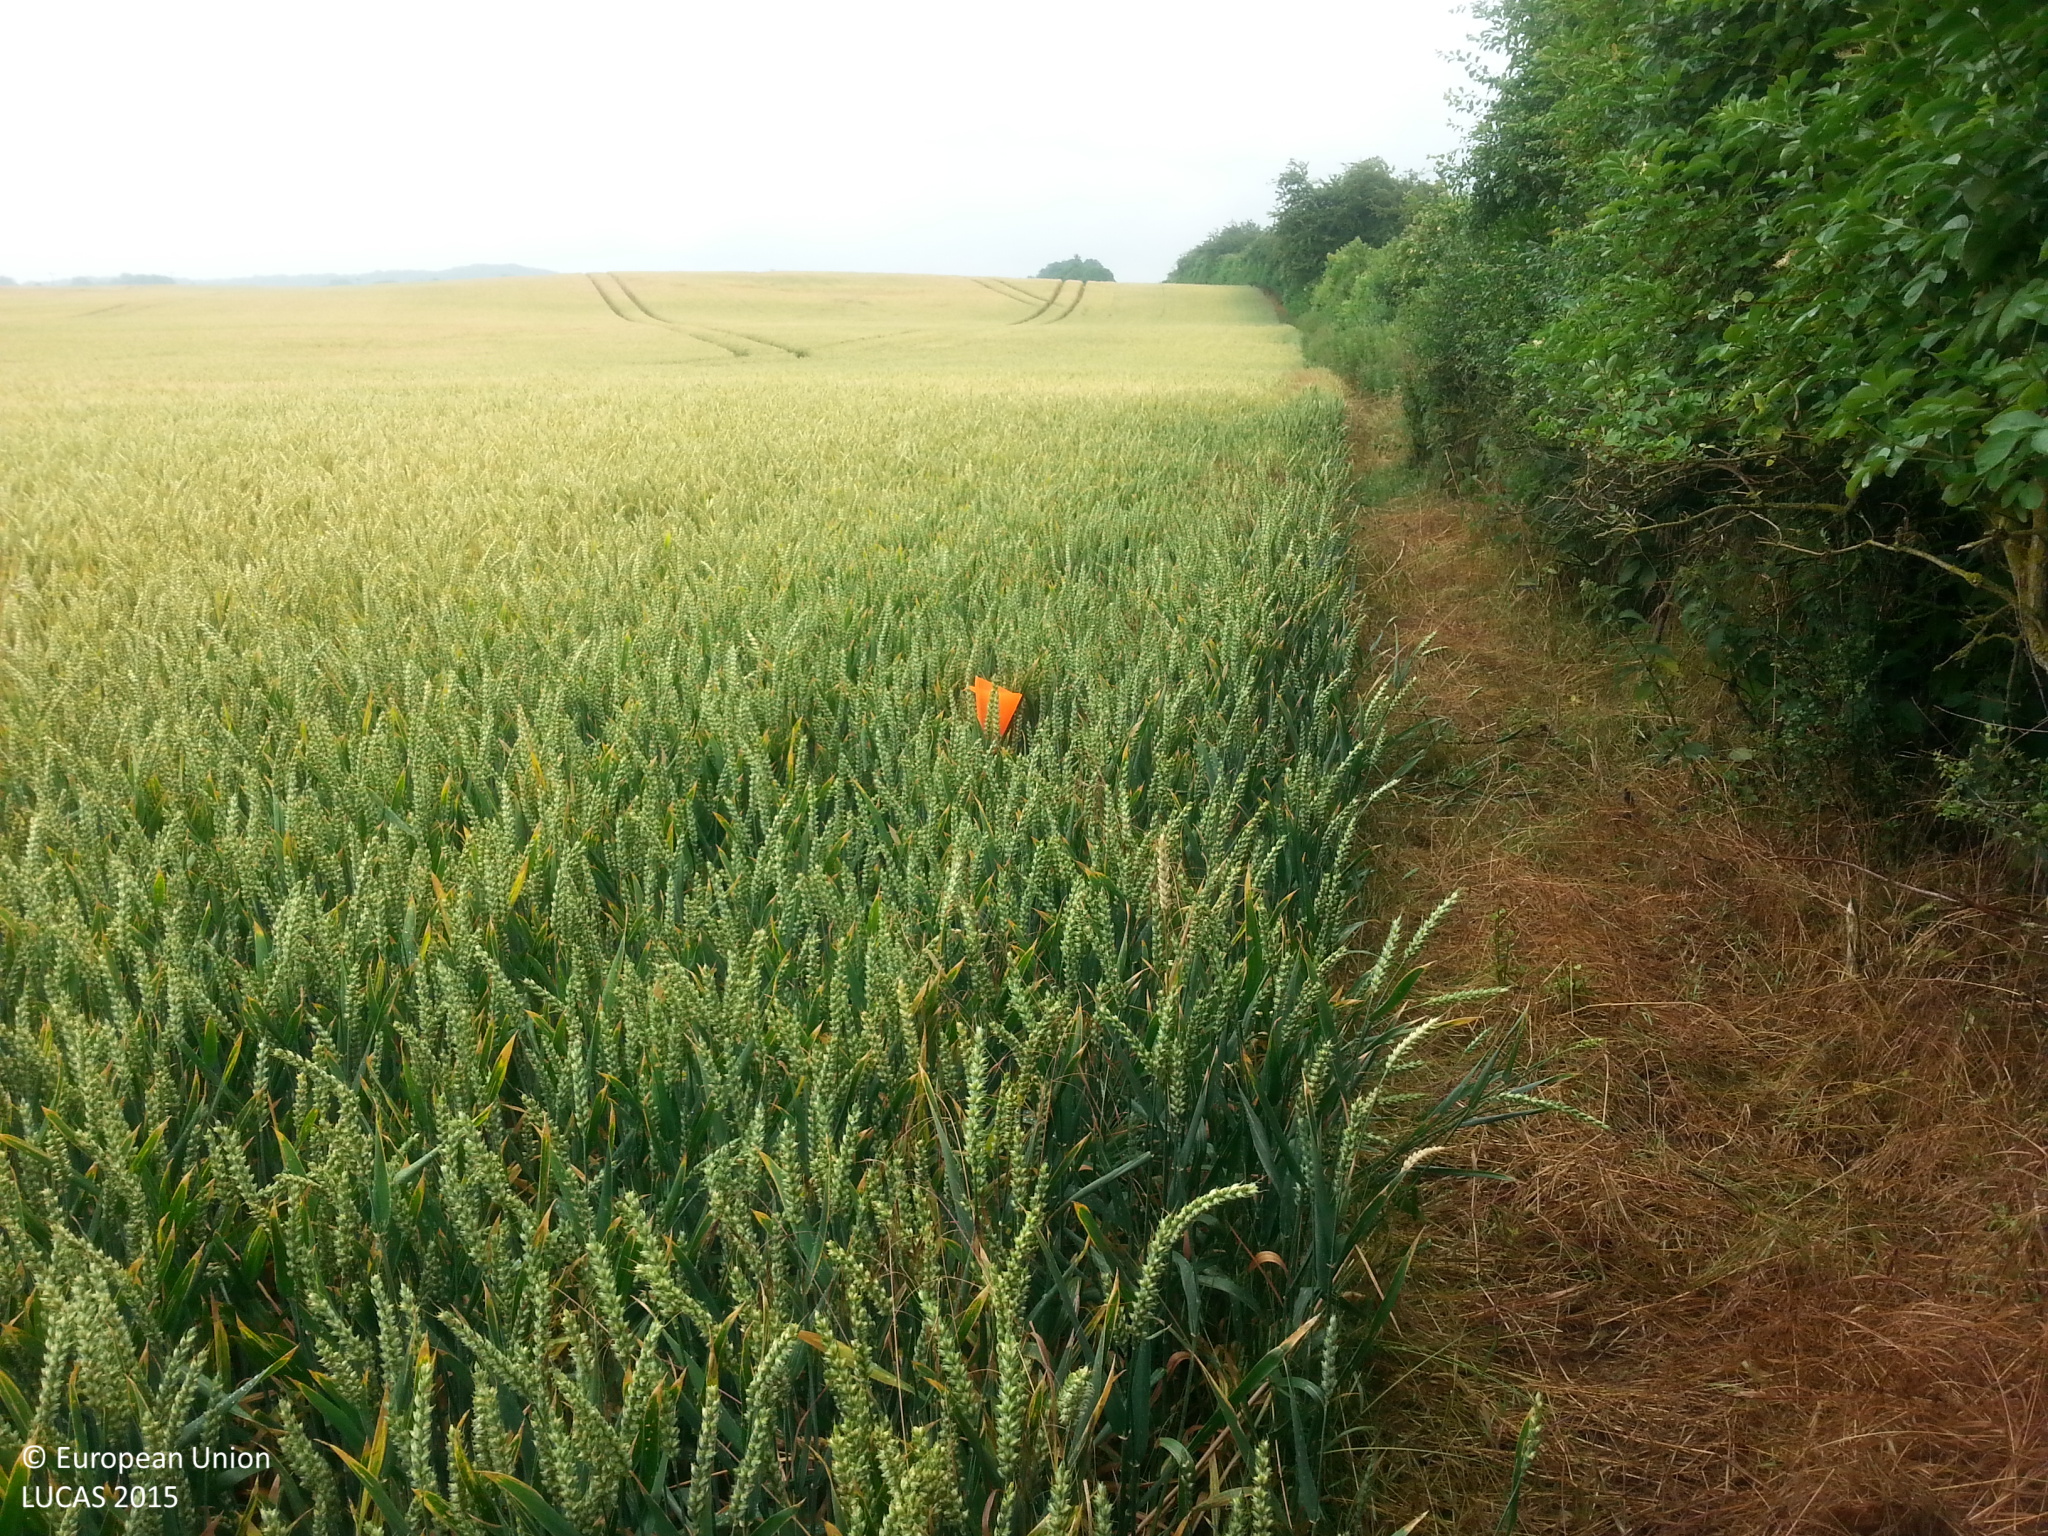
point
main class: Cropland
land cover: Common wheat
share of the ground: > 75 %
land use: Agriculture (excluding fallow land and kitchen gardens)
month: July
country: DE
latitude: 53.8951
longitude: 11.5666
